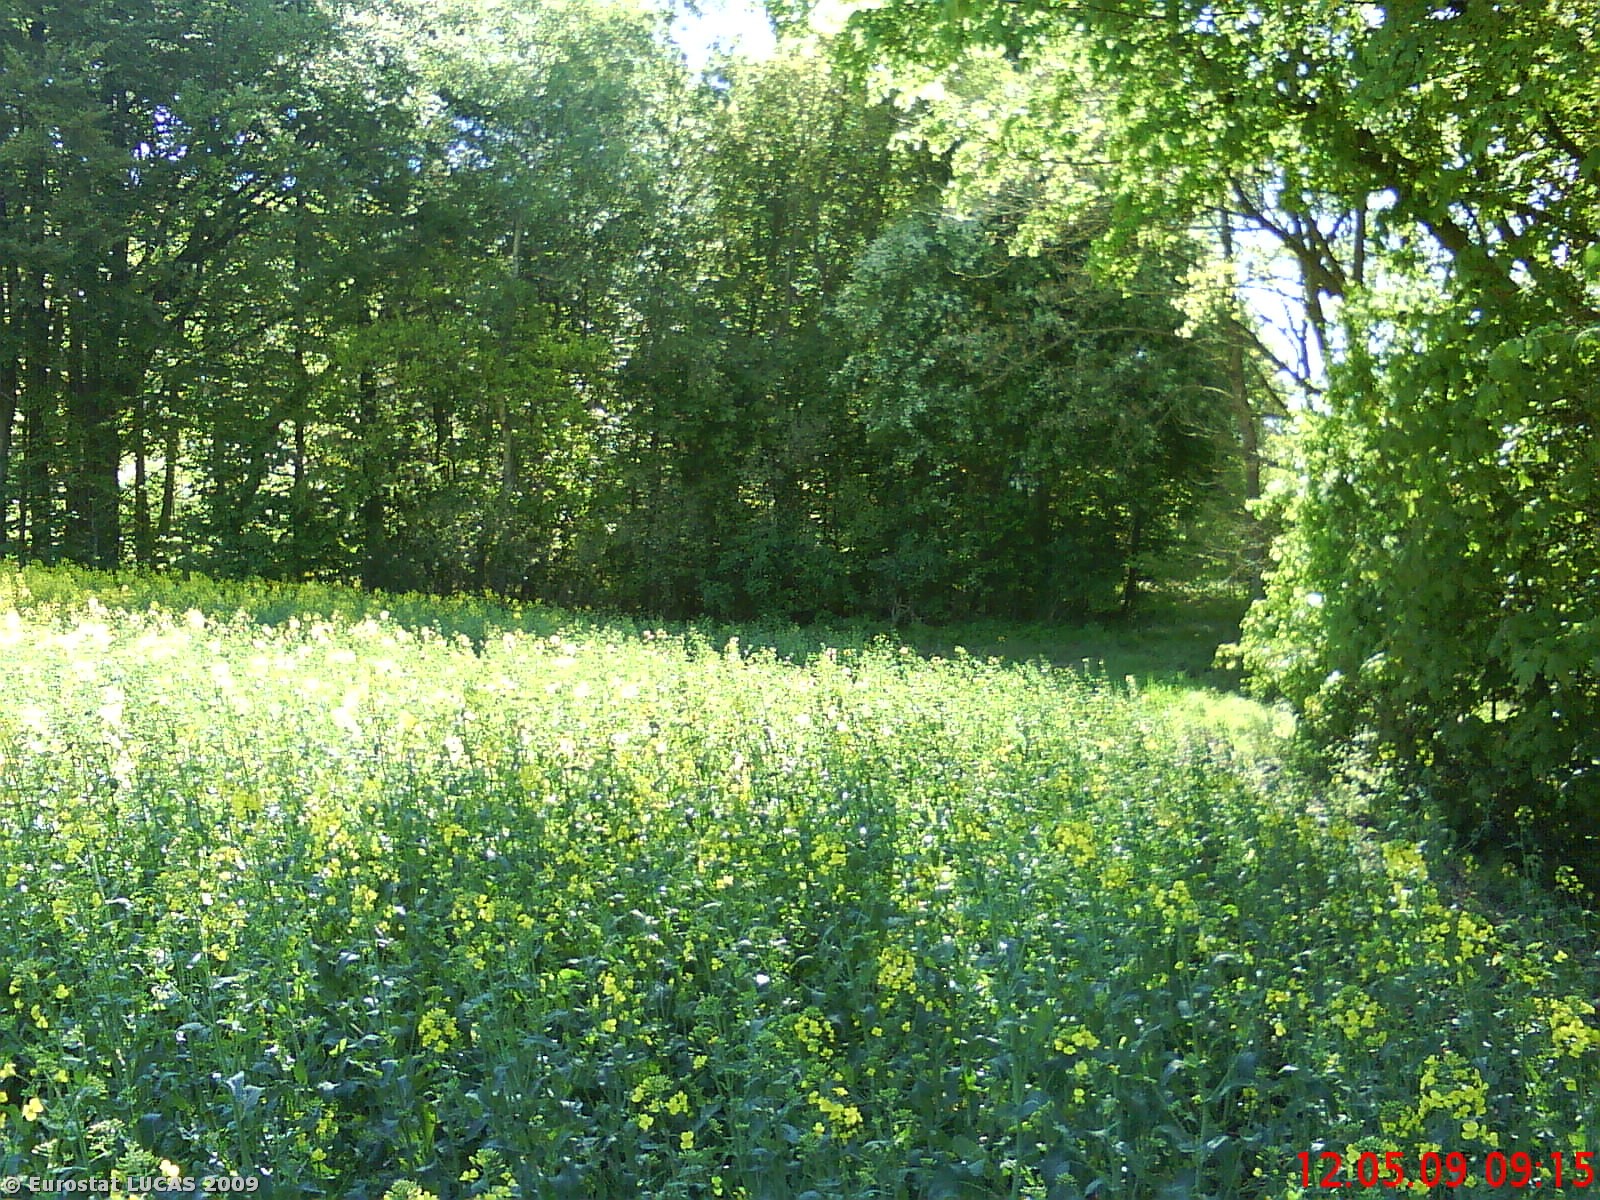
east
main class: Cropland
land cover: Rape and turnip rape
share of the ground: > 75 %
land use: Agriculture (excluding fallow land and kitchen gardens)
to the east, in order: Rape and turnip rape; Broadleaved woodland; Ditches and canals; Broadleaved woodland; Grass margins; Barley
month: May
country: DK
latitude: 56.3291
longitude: 10.7915
